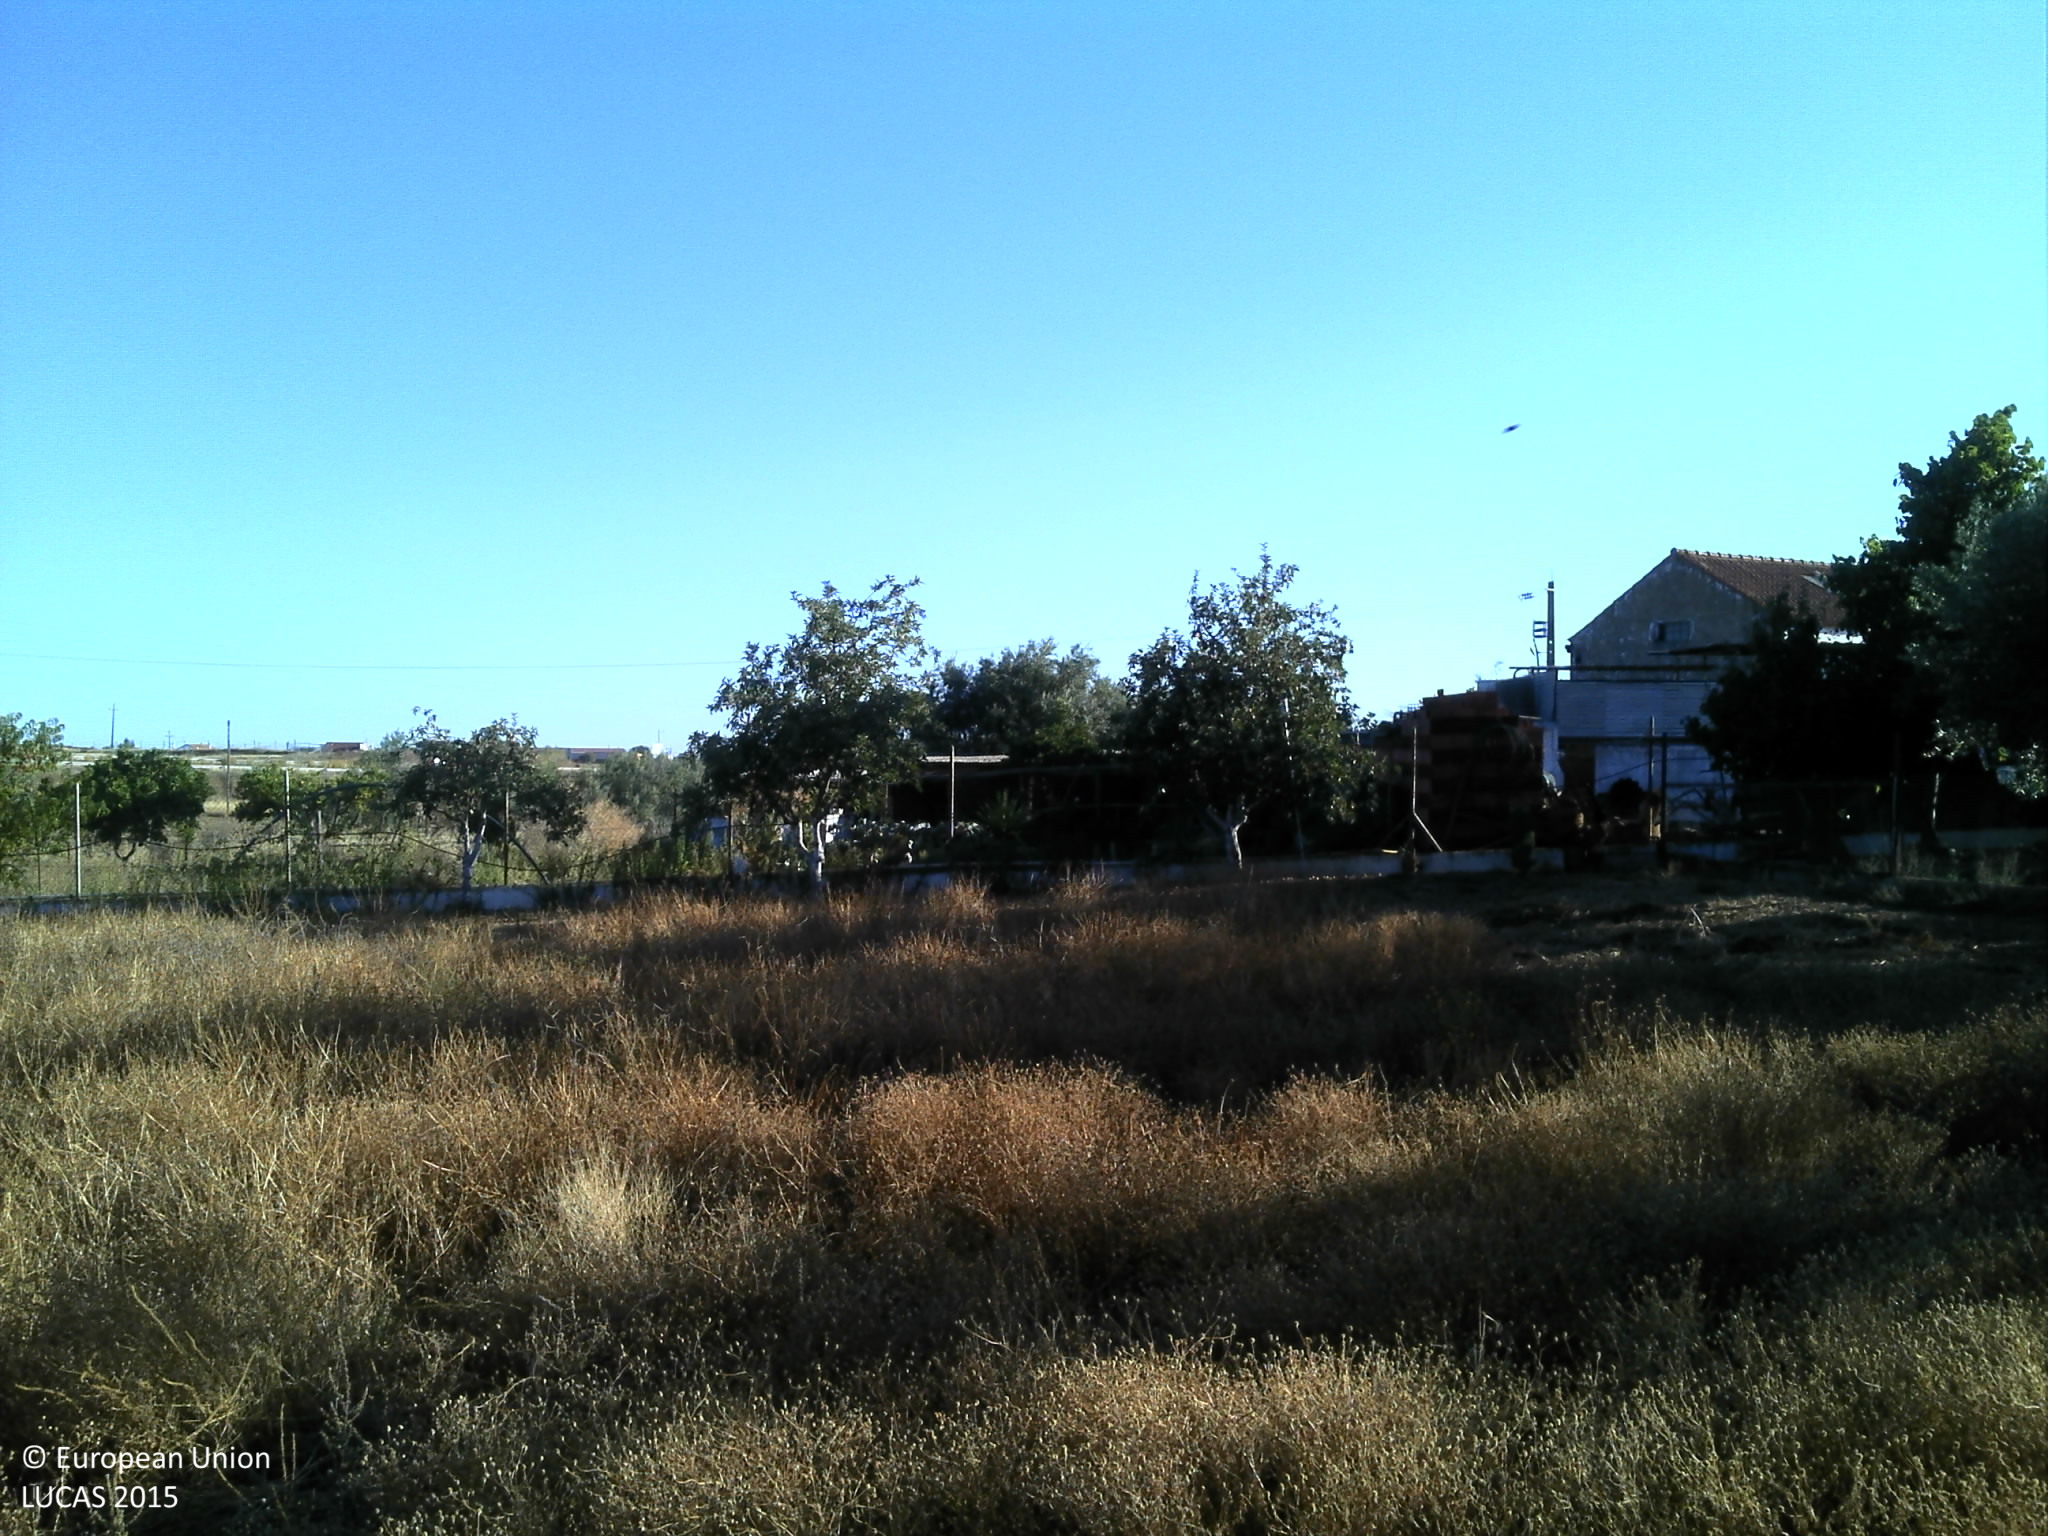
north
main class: Shrubland
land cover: Shrubland without tree cover
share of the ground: 50 - 75 %
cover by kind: unconsolidated bare surface 50 %, shrubs 25 %, herbaceous plants 25 %
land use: Fallow land
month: July
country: PT
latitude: 38.8929
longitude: -7.5501
